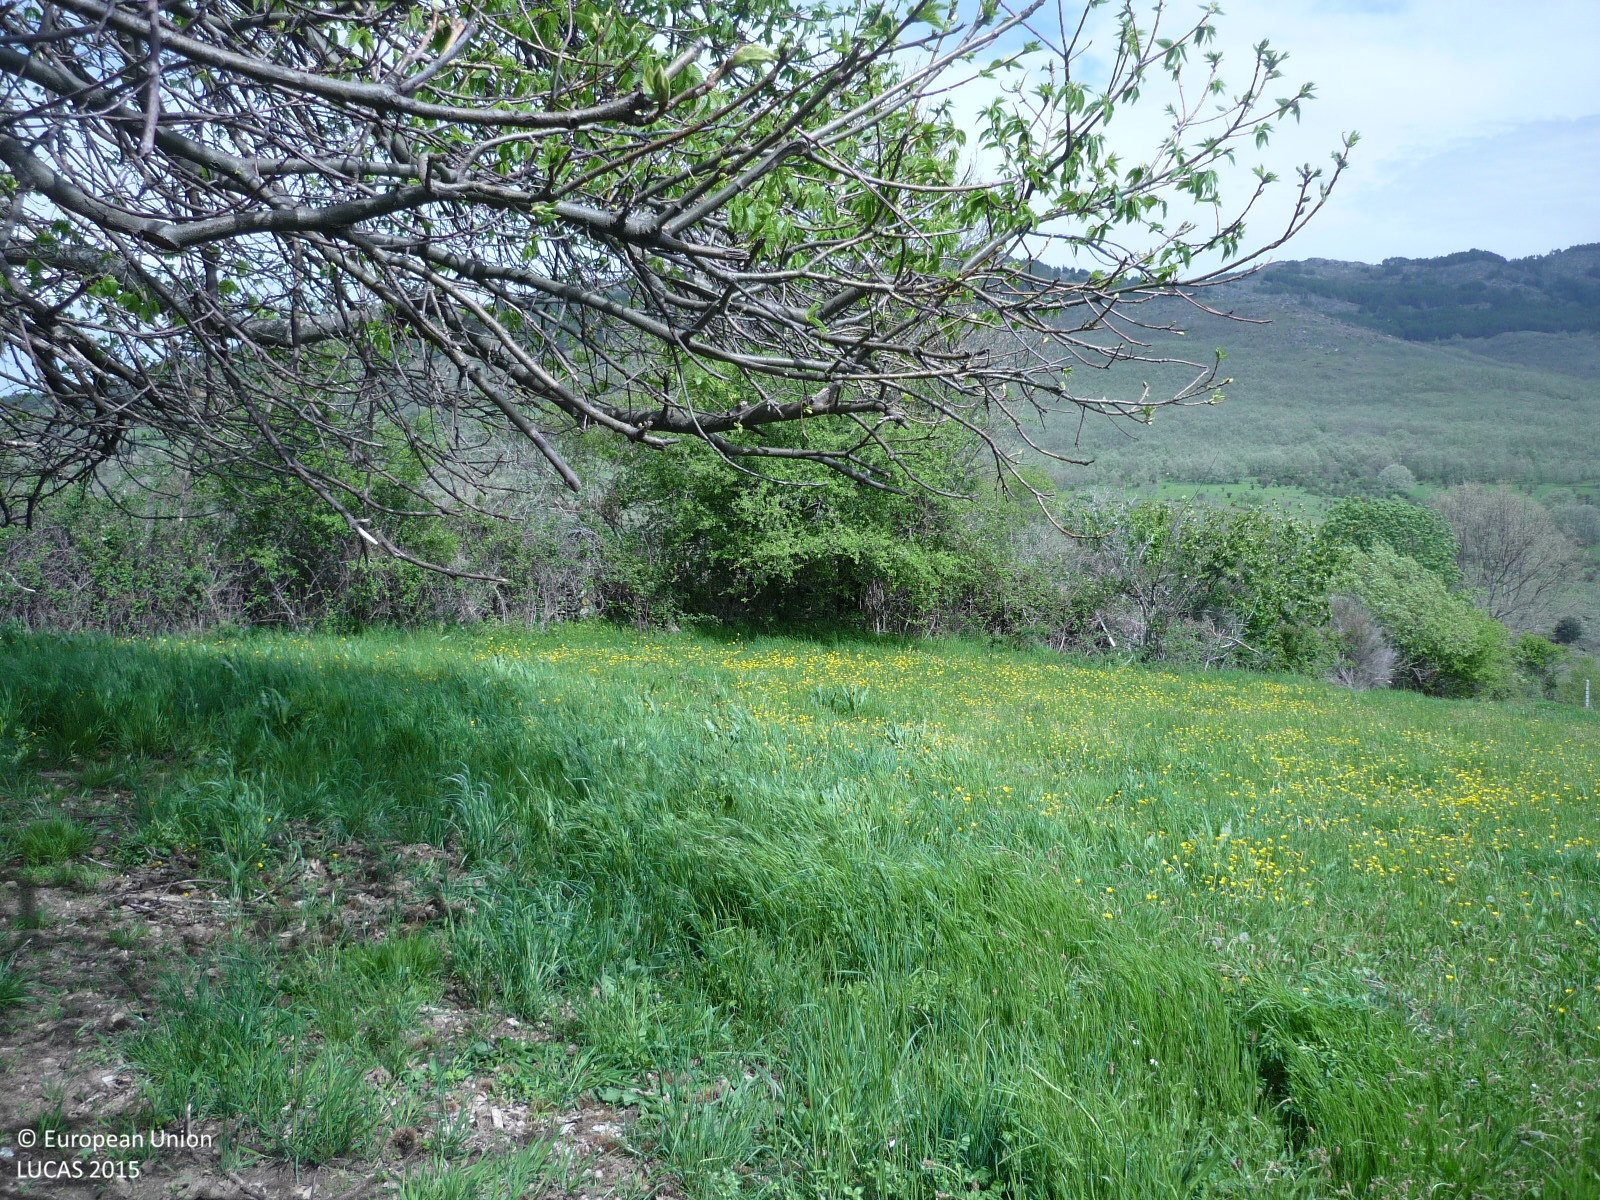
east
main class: Shrubland
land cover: Shrubland with sparse tree cover
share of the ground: > 75 %
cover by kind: shrubs 85 %, herbaceous plants 10 %, broadleaved forest trees 5 %
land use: Semi-natural and natural areas not in use
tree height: < 5 m
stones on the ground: < 10 %
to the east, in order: Shrubland with sparse tree cover; Dry stone walls; Grassland with sparse tree/shrub cover; Dry stone walls; Tracks; Dry stone walls; Grassland with sparse tree/shrub cover; Dry stone walls; Grassland with sparse tree/shrub cover; Dry stone walls; Broadleaved woodland
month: May
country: ES
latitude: 41.0862
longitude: -3.5067
